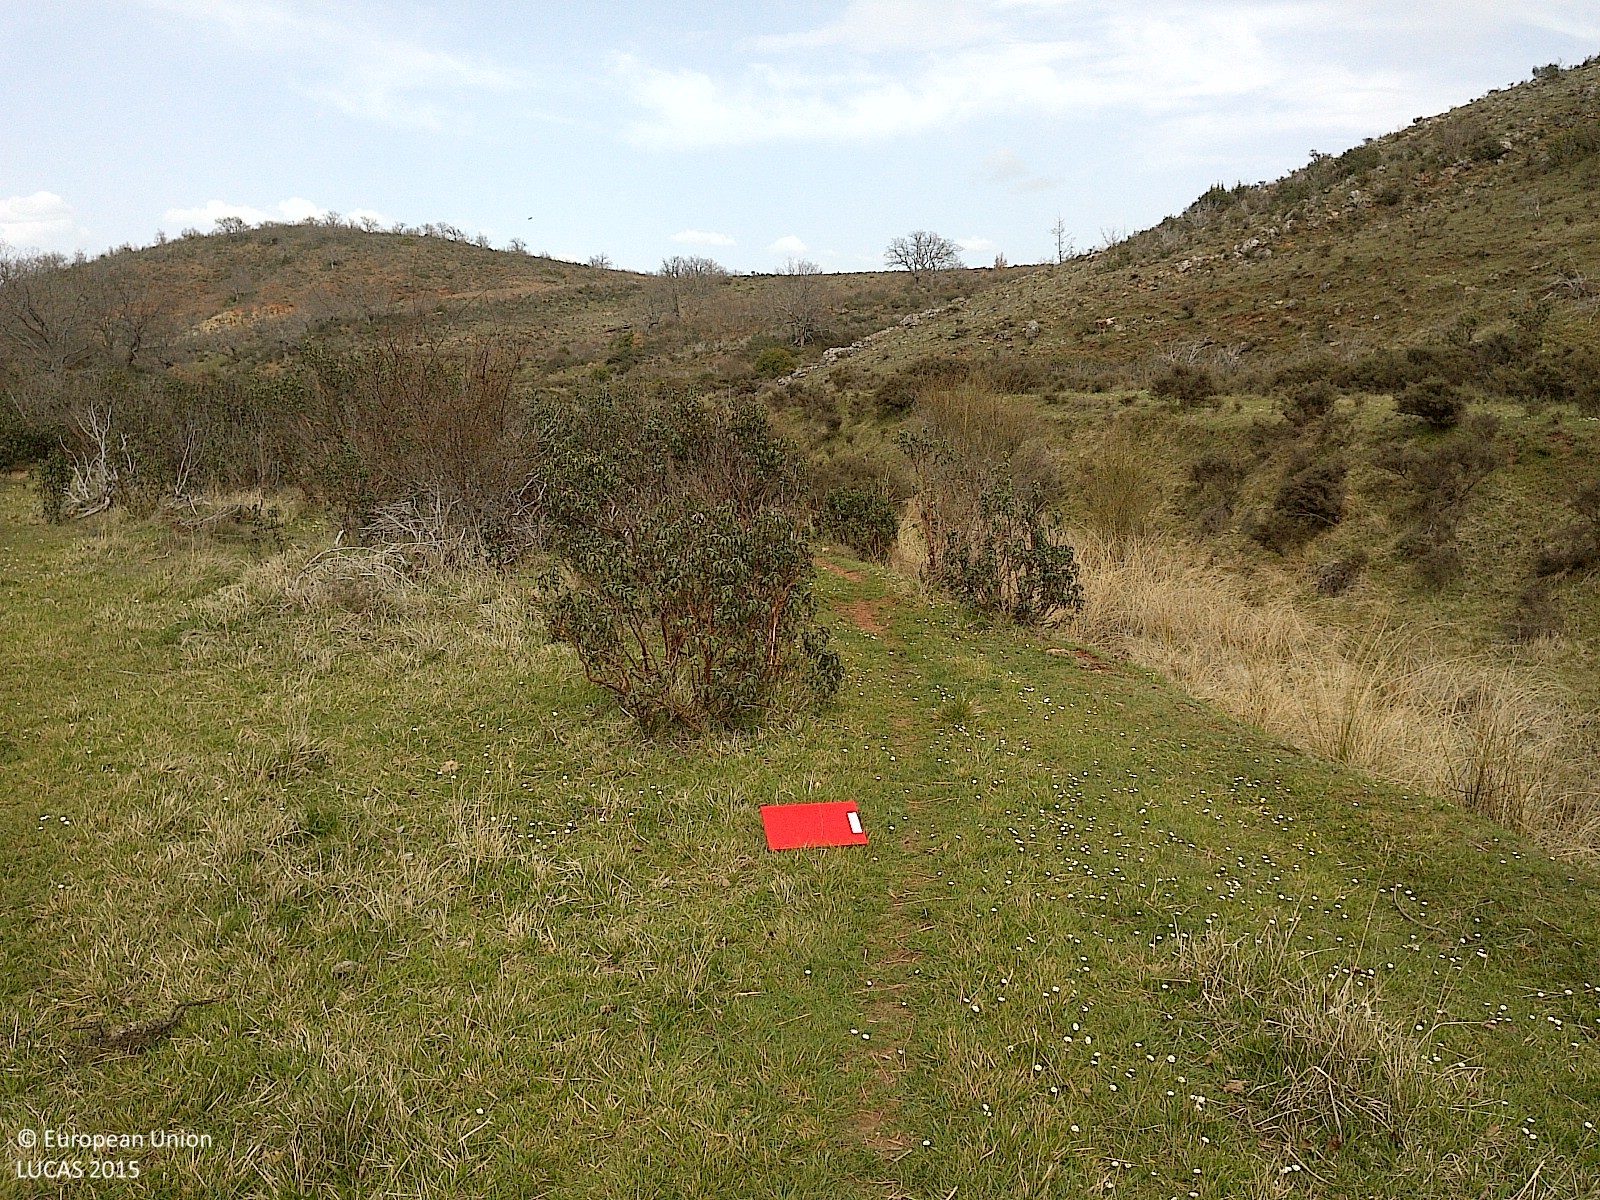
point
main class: Shrubland
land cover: Shrubland without tree cover
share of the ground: 25 - 50 %
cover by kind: herbaceous plants 55 %, shrubs 45 %
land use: Agriculture (excluding fallow land and kitchen gardens)
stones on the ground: < 10 %
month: April
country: ES
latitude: 42.0816
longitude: -3.3129
